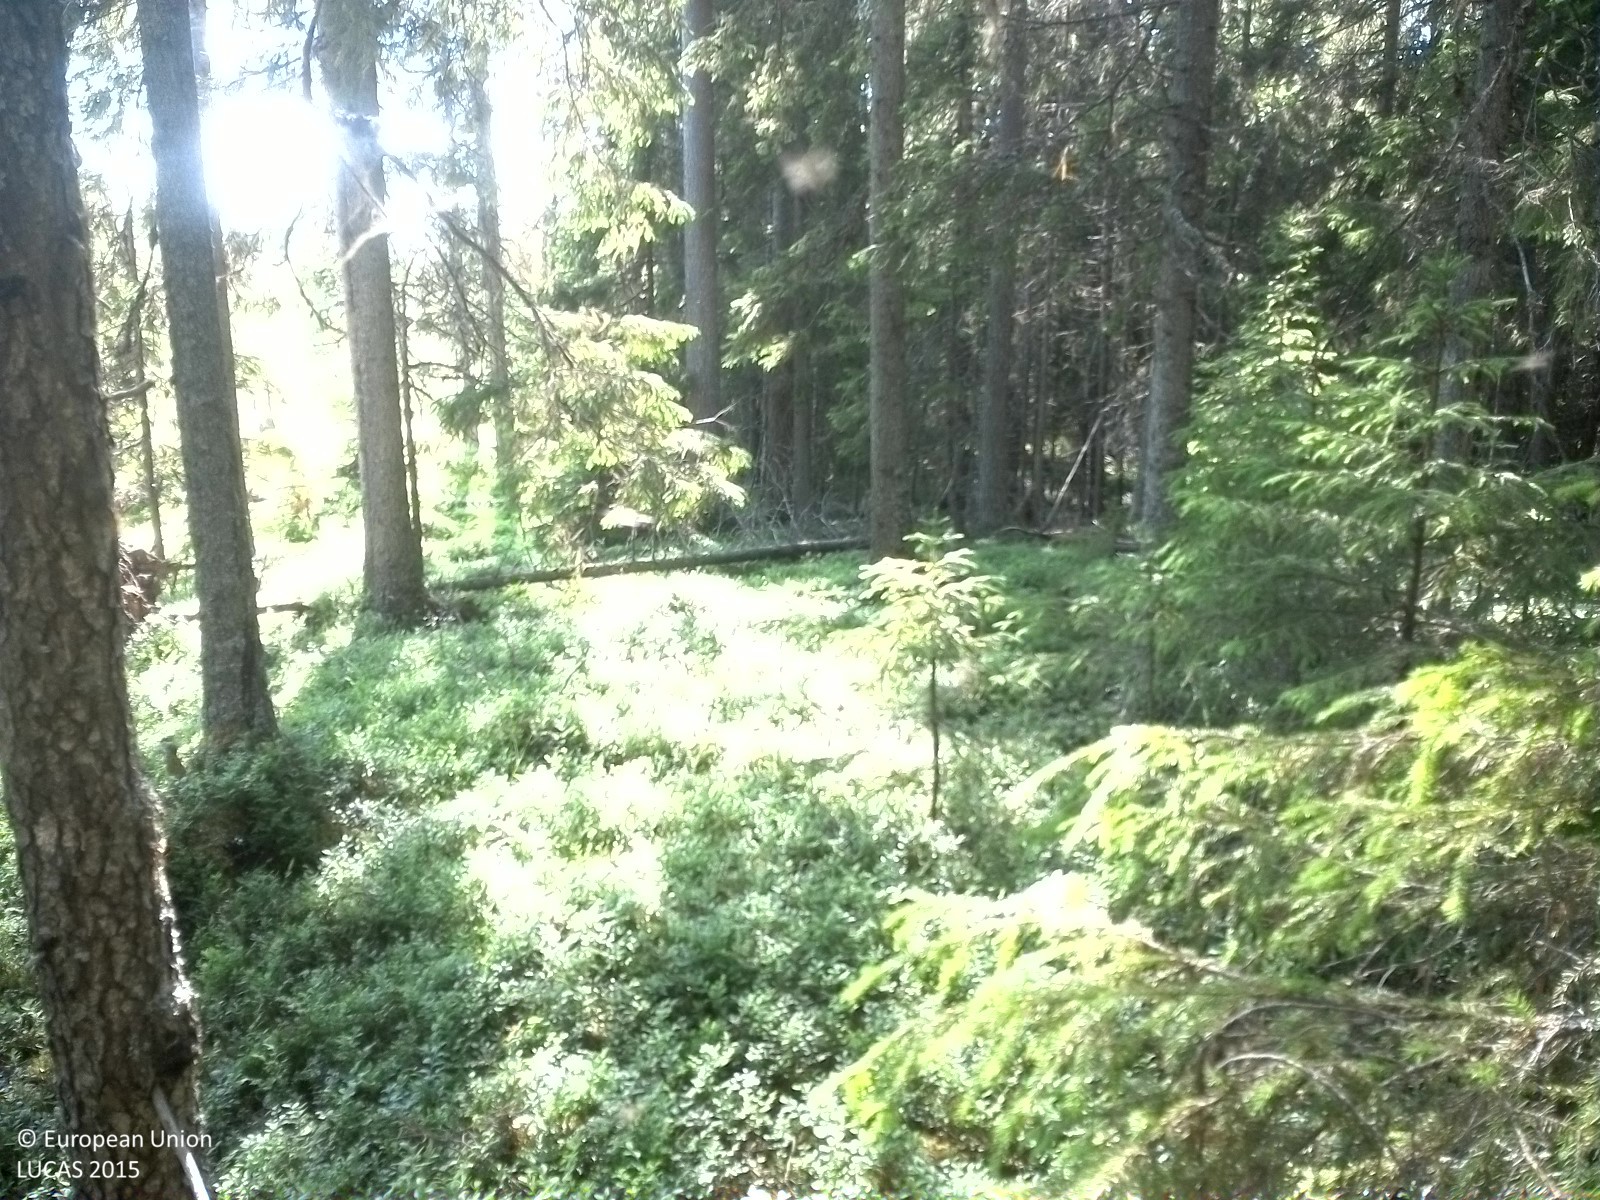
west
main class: Woodland
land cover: Spruce dominated coniferous woodland
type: boreal forest
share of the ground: > 75 %
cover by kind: coniferous forest trees 80 %, shrubs 20 %
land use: Forestry
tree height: > 5 m
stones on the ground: < 10 %
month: July
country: SE
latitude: 63.6267
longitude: 15.1609
